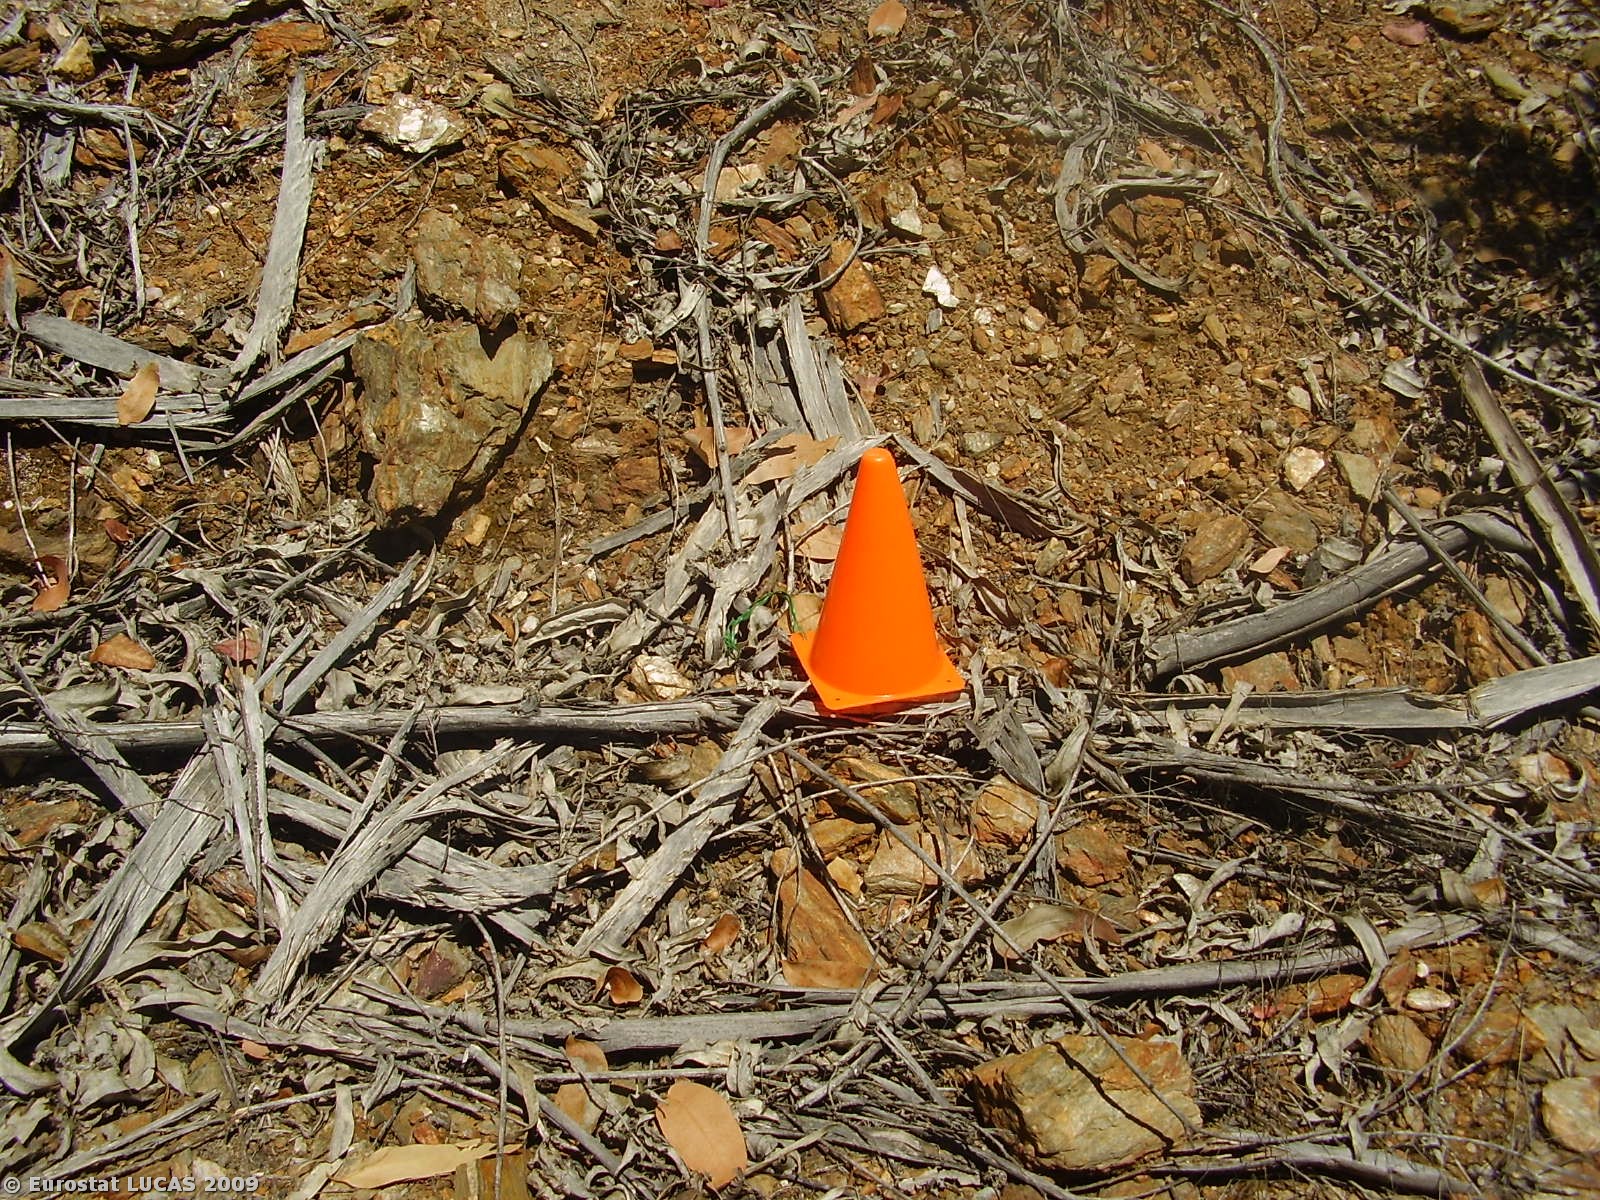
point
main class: Woodland
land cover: Broadleaved woodland
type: plantations and self-sown exotic forest
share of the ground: 25 - 50 %
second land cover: Spontaneously vegetated surfaces
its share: < 10 %
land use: Forestry
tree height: > 5 m
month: May
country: PT
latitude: 41.3730
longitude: -7.3011
